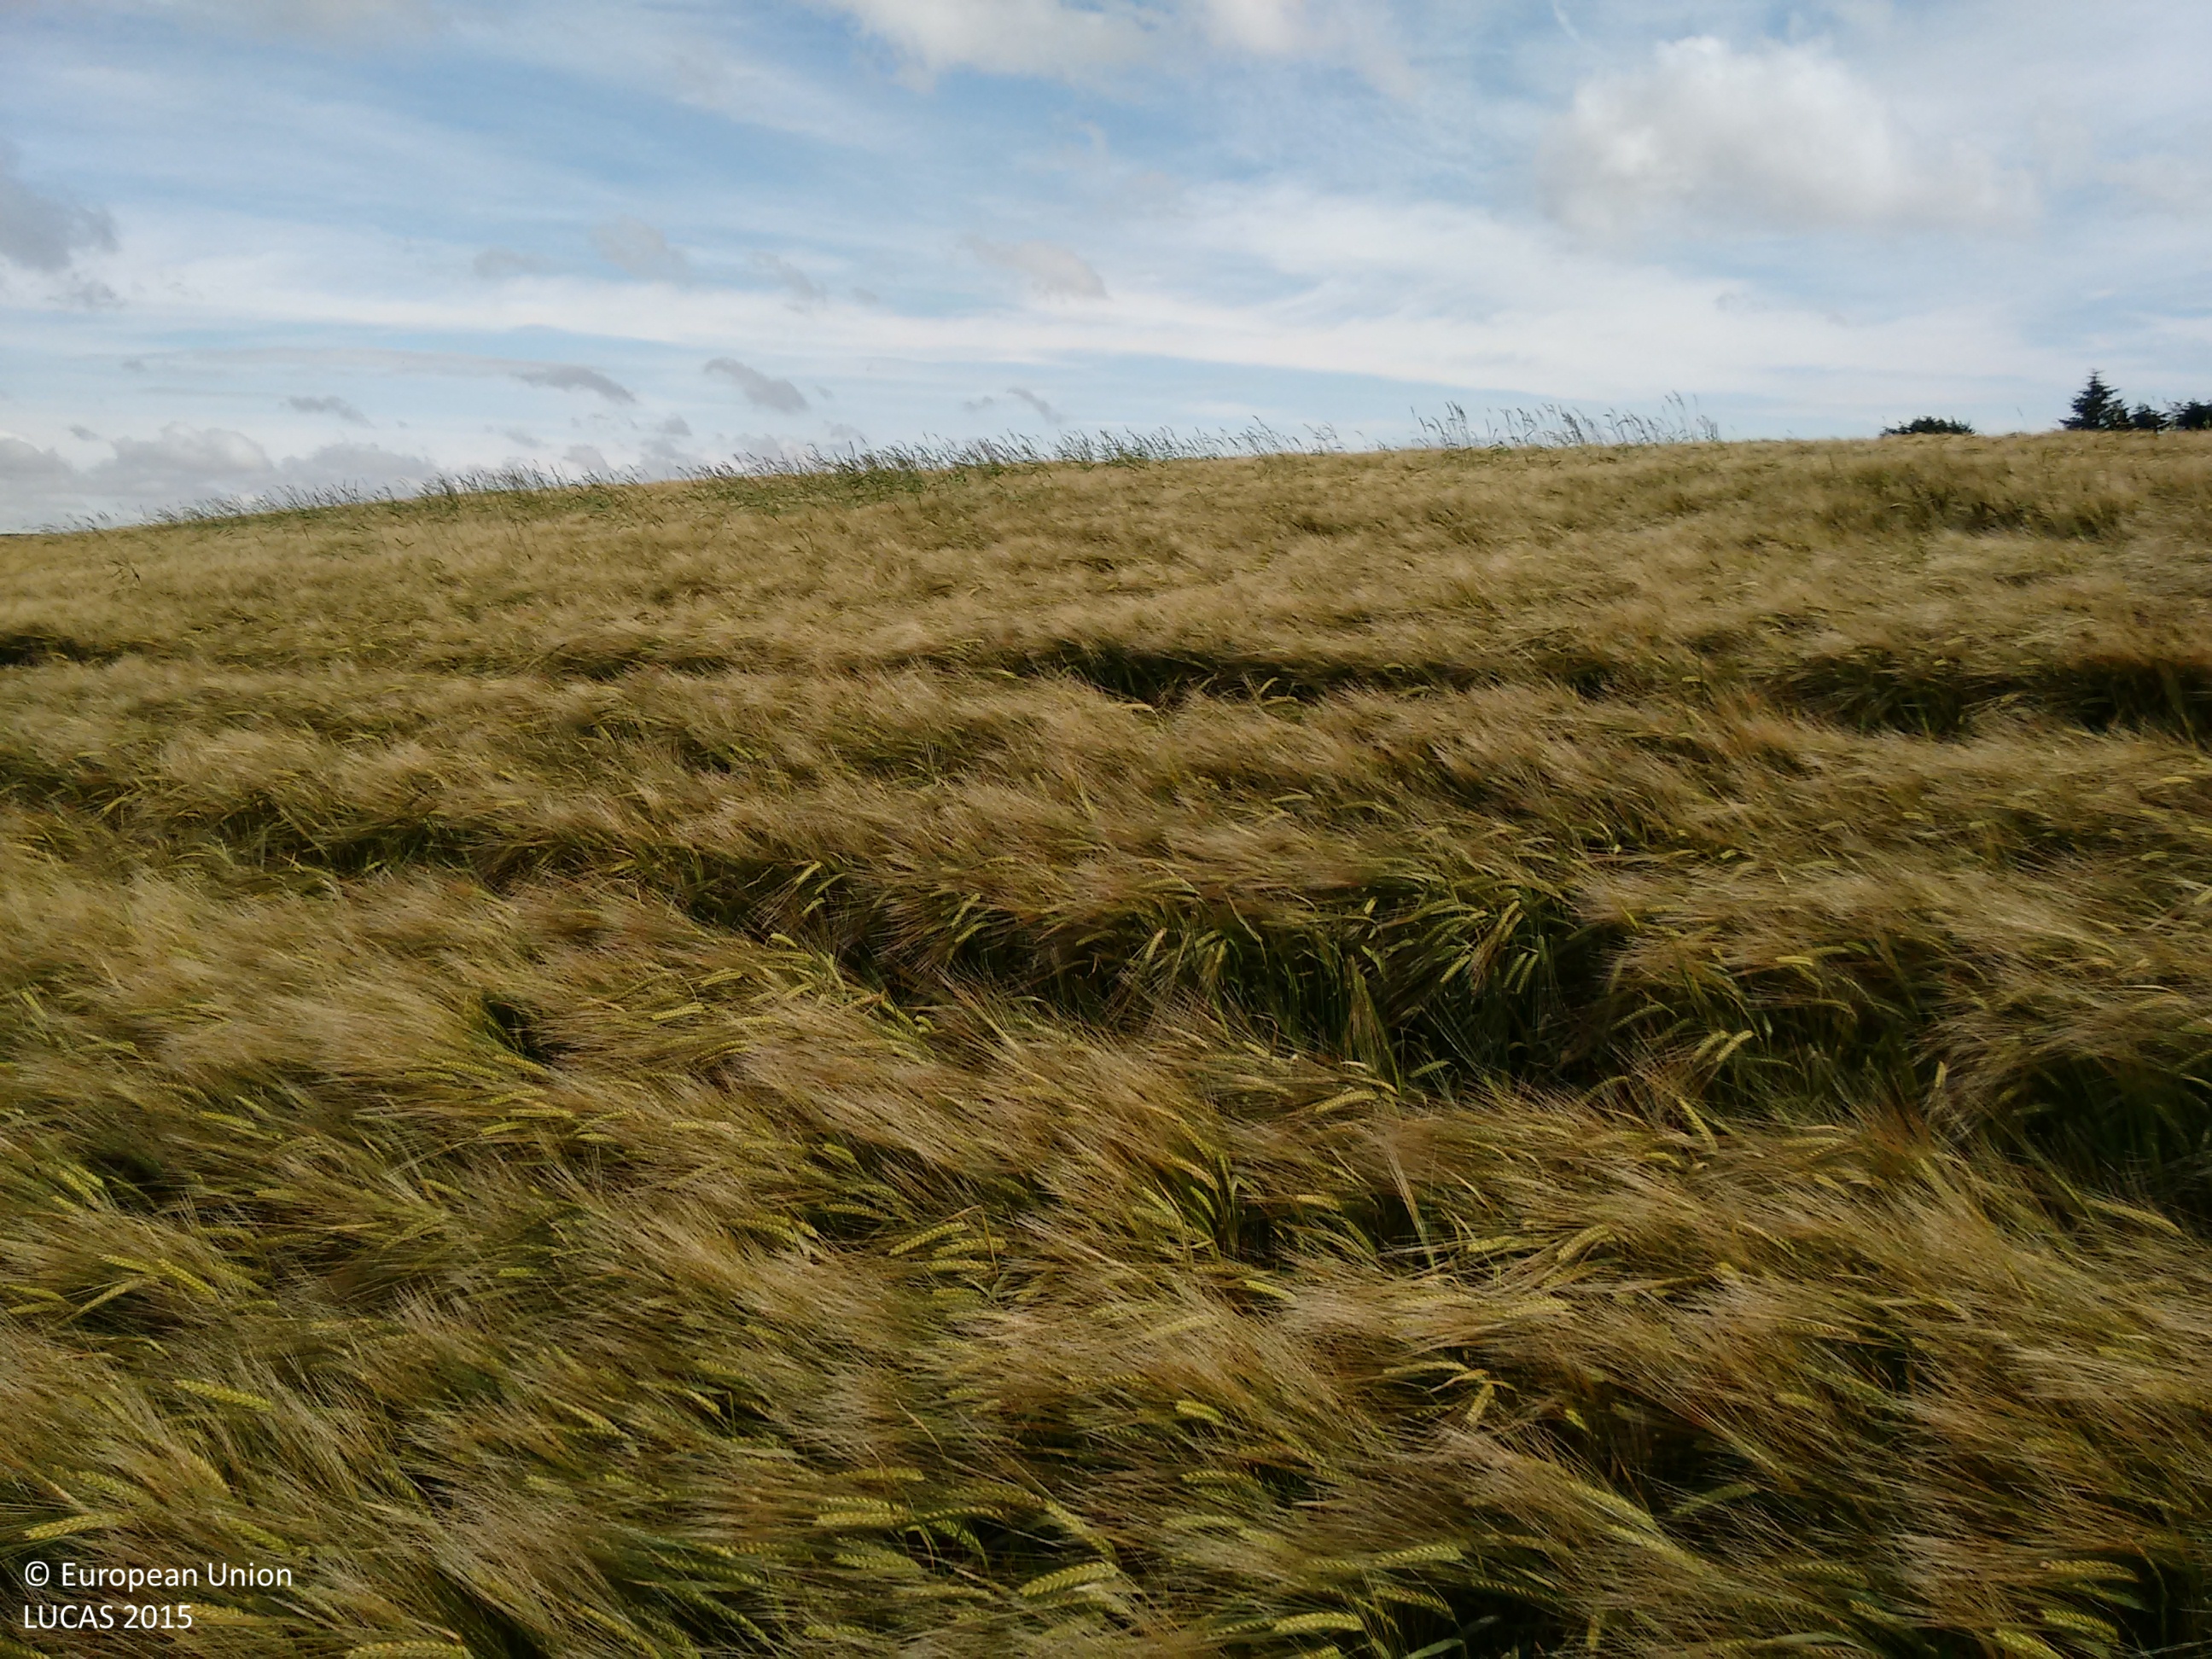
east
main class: Cropland
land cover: Barley
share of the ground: > 75 %
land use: Agriculture (excluding fallow land and kitchen gardens)
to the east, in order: Barley; Grass margins; Fences; Grass margins; Tracks; Grass margins; Fences; Grass margins; Barley
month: August
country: GB
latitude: 57.5698
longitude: -2.2026
